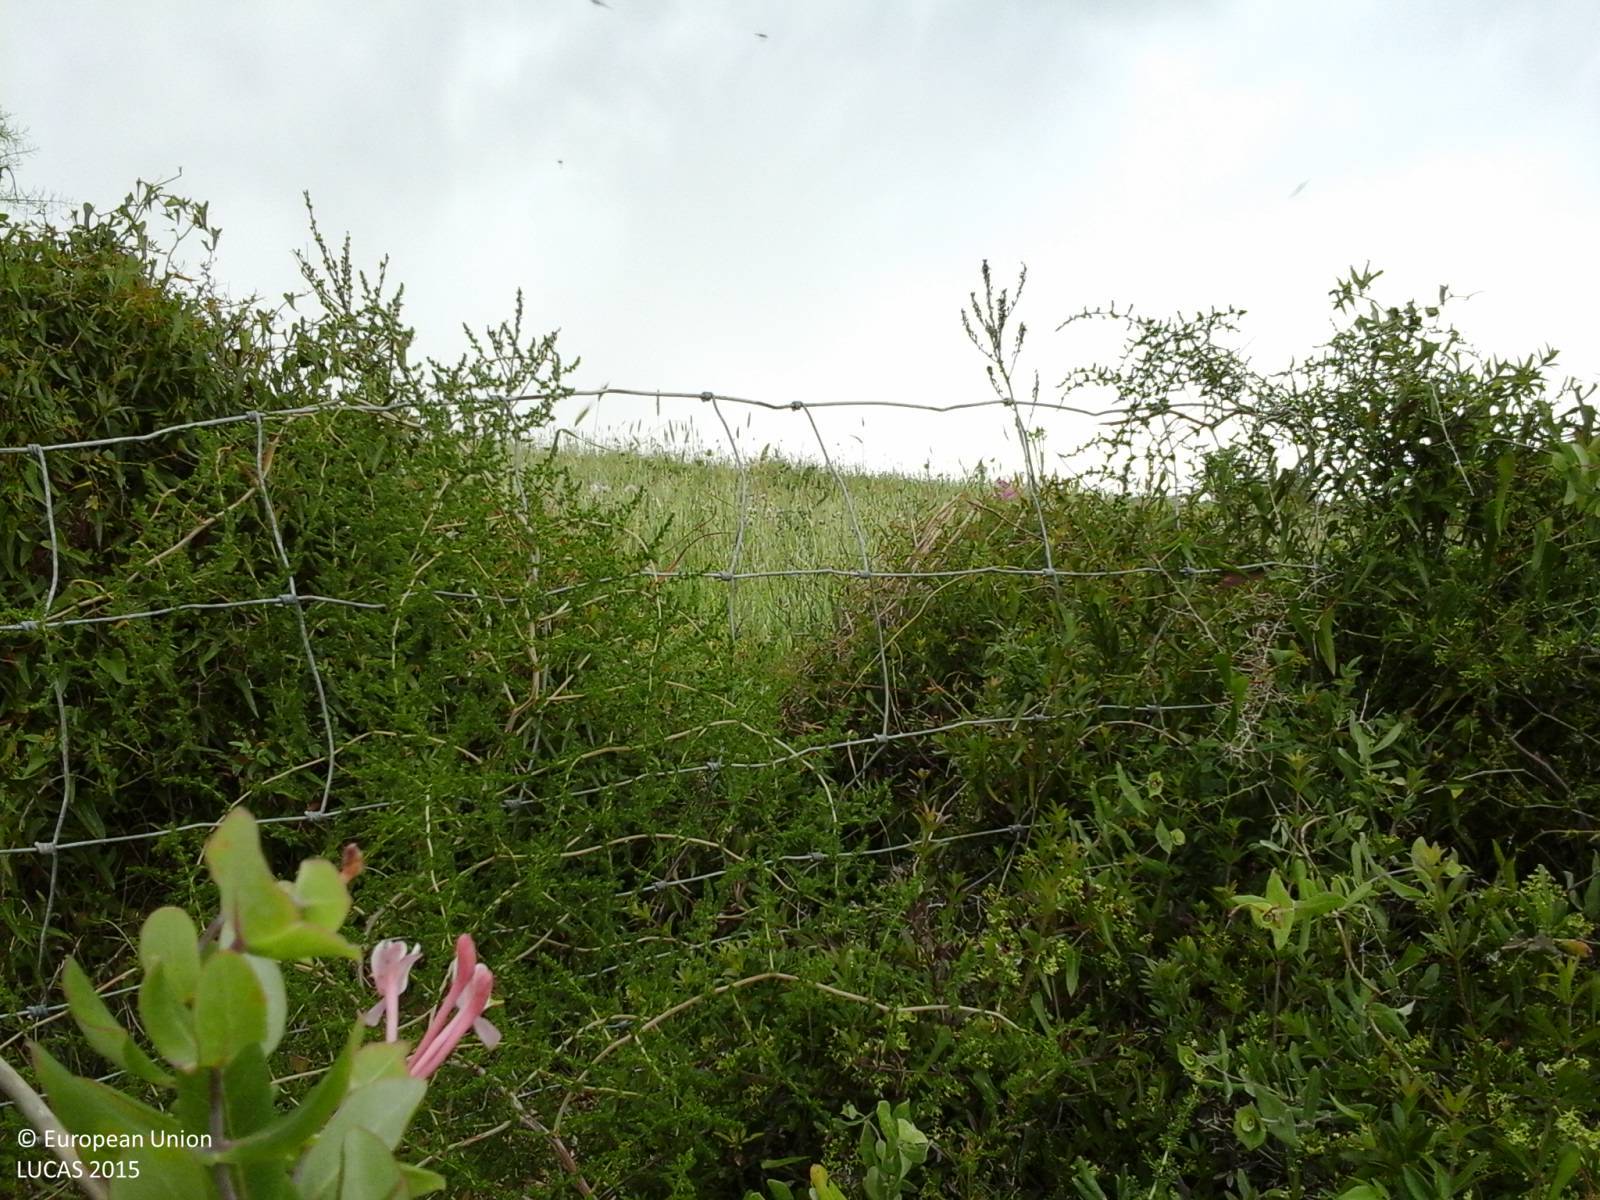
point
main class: Grassland
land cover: Grassland without tree/shrub cover
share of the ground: > 75 %
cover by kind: herbaceous plants 95 %, shrubs 5 %
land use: Agriculture (excluding fallow land and kitchen gardens)
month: May
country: IT
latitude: 39.7530
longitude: 8.8047
